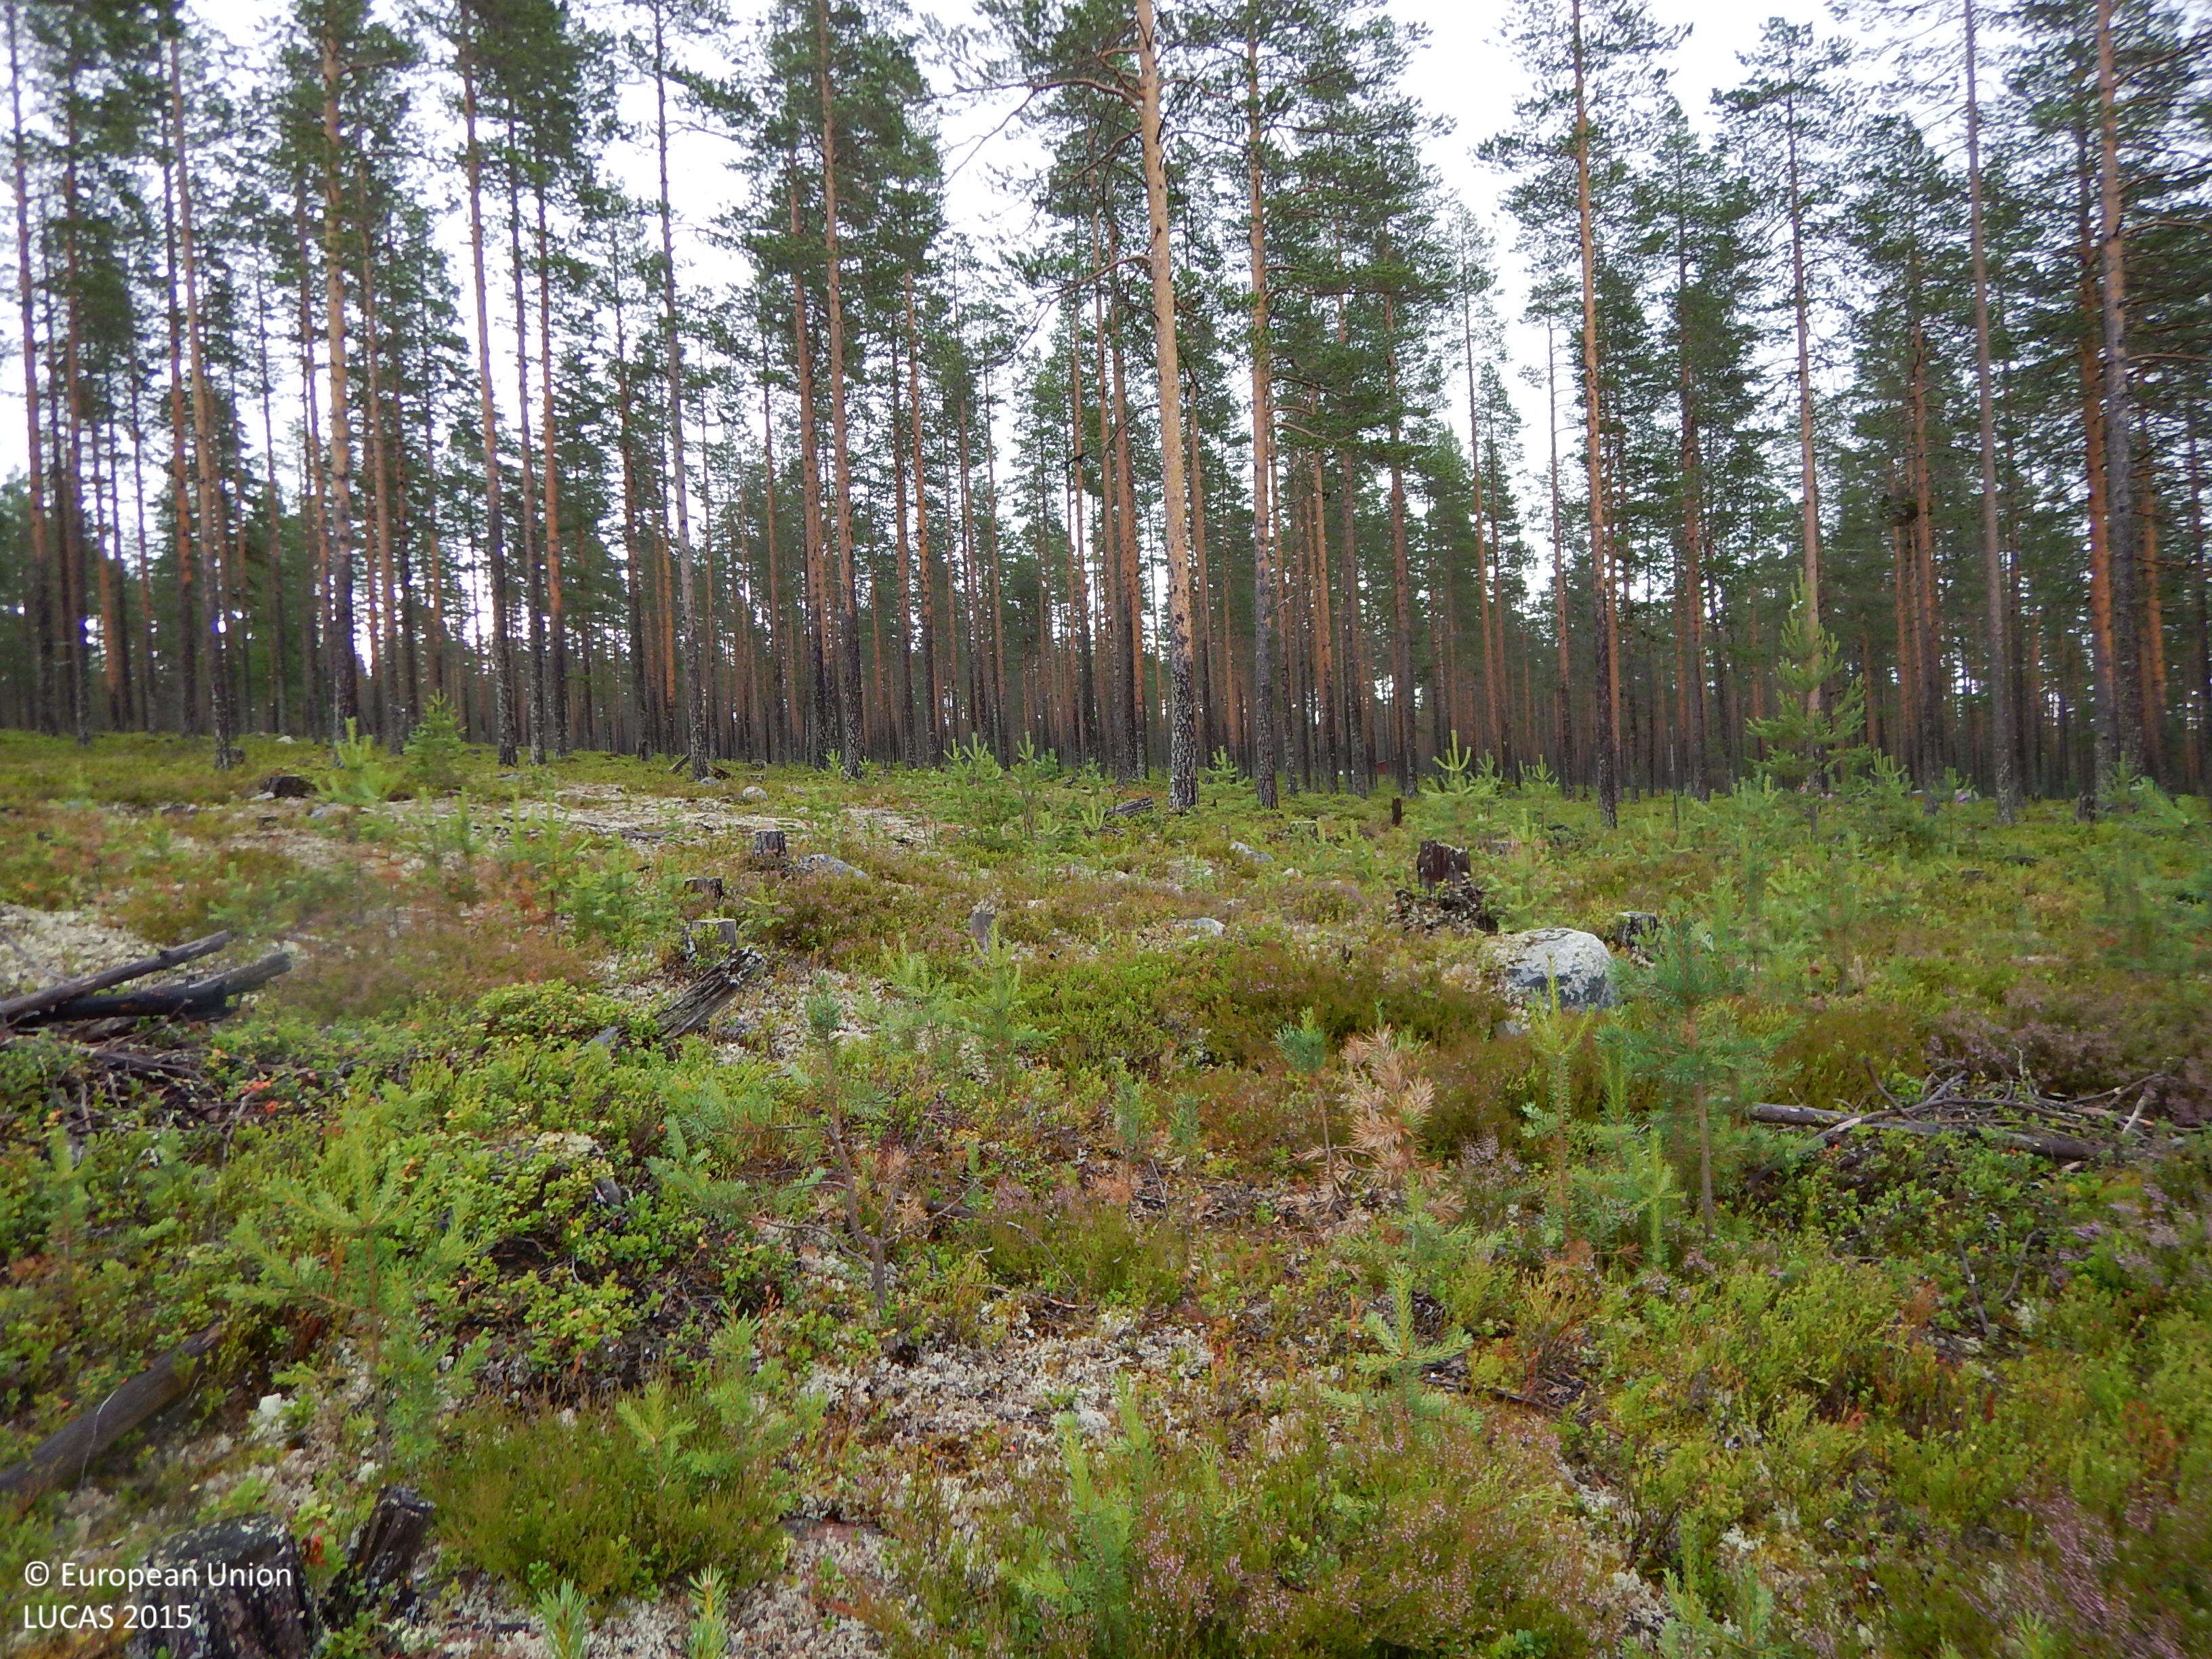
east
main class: Woodland
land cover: Pine dominated coniferous woodland
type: boreal forest
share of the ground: 10 - 25 %
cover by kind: shrubs 25 %, lichens and mosses 25 %, herbaceous plants 20 %, coniferous forest trees 15 %, unconsolidated bare surface 10 %, broadleaved forest trees 5 %
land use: Forestry
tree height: < 5 m
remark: Clear cut
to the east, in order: Pine dominated coniferous woodland; Tracks; Pine dominated coniferous woodland
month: July
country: SE
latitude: 64.9425
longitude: 20.2343
